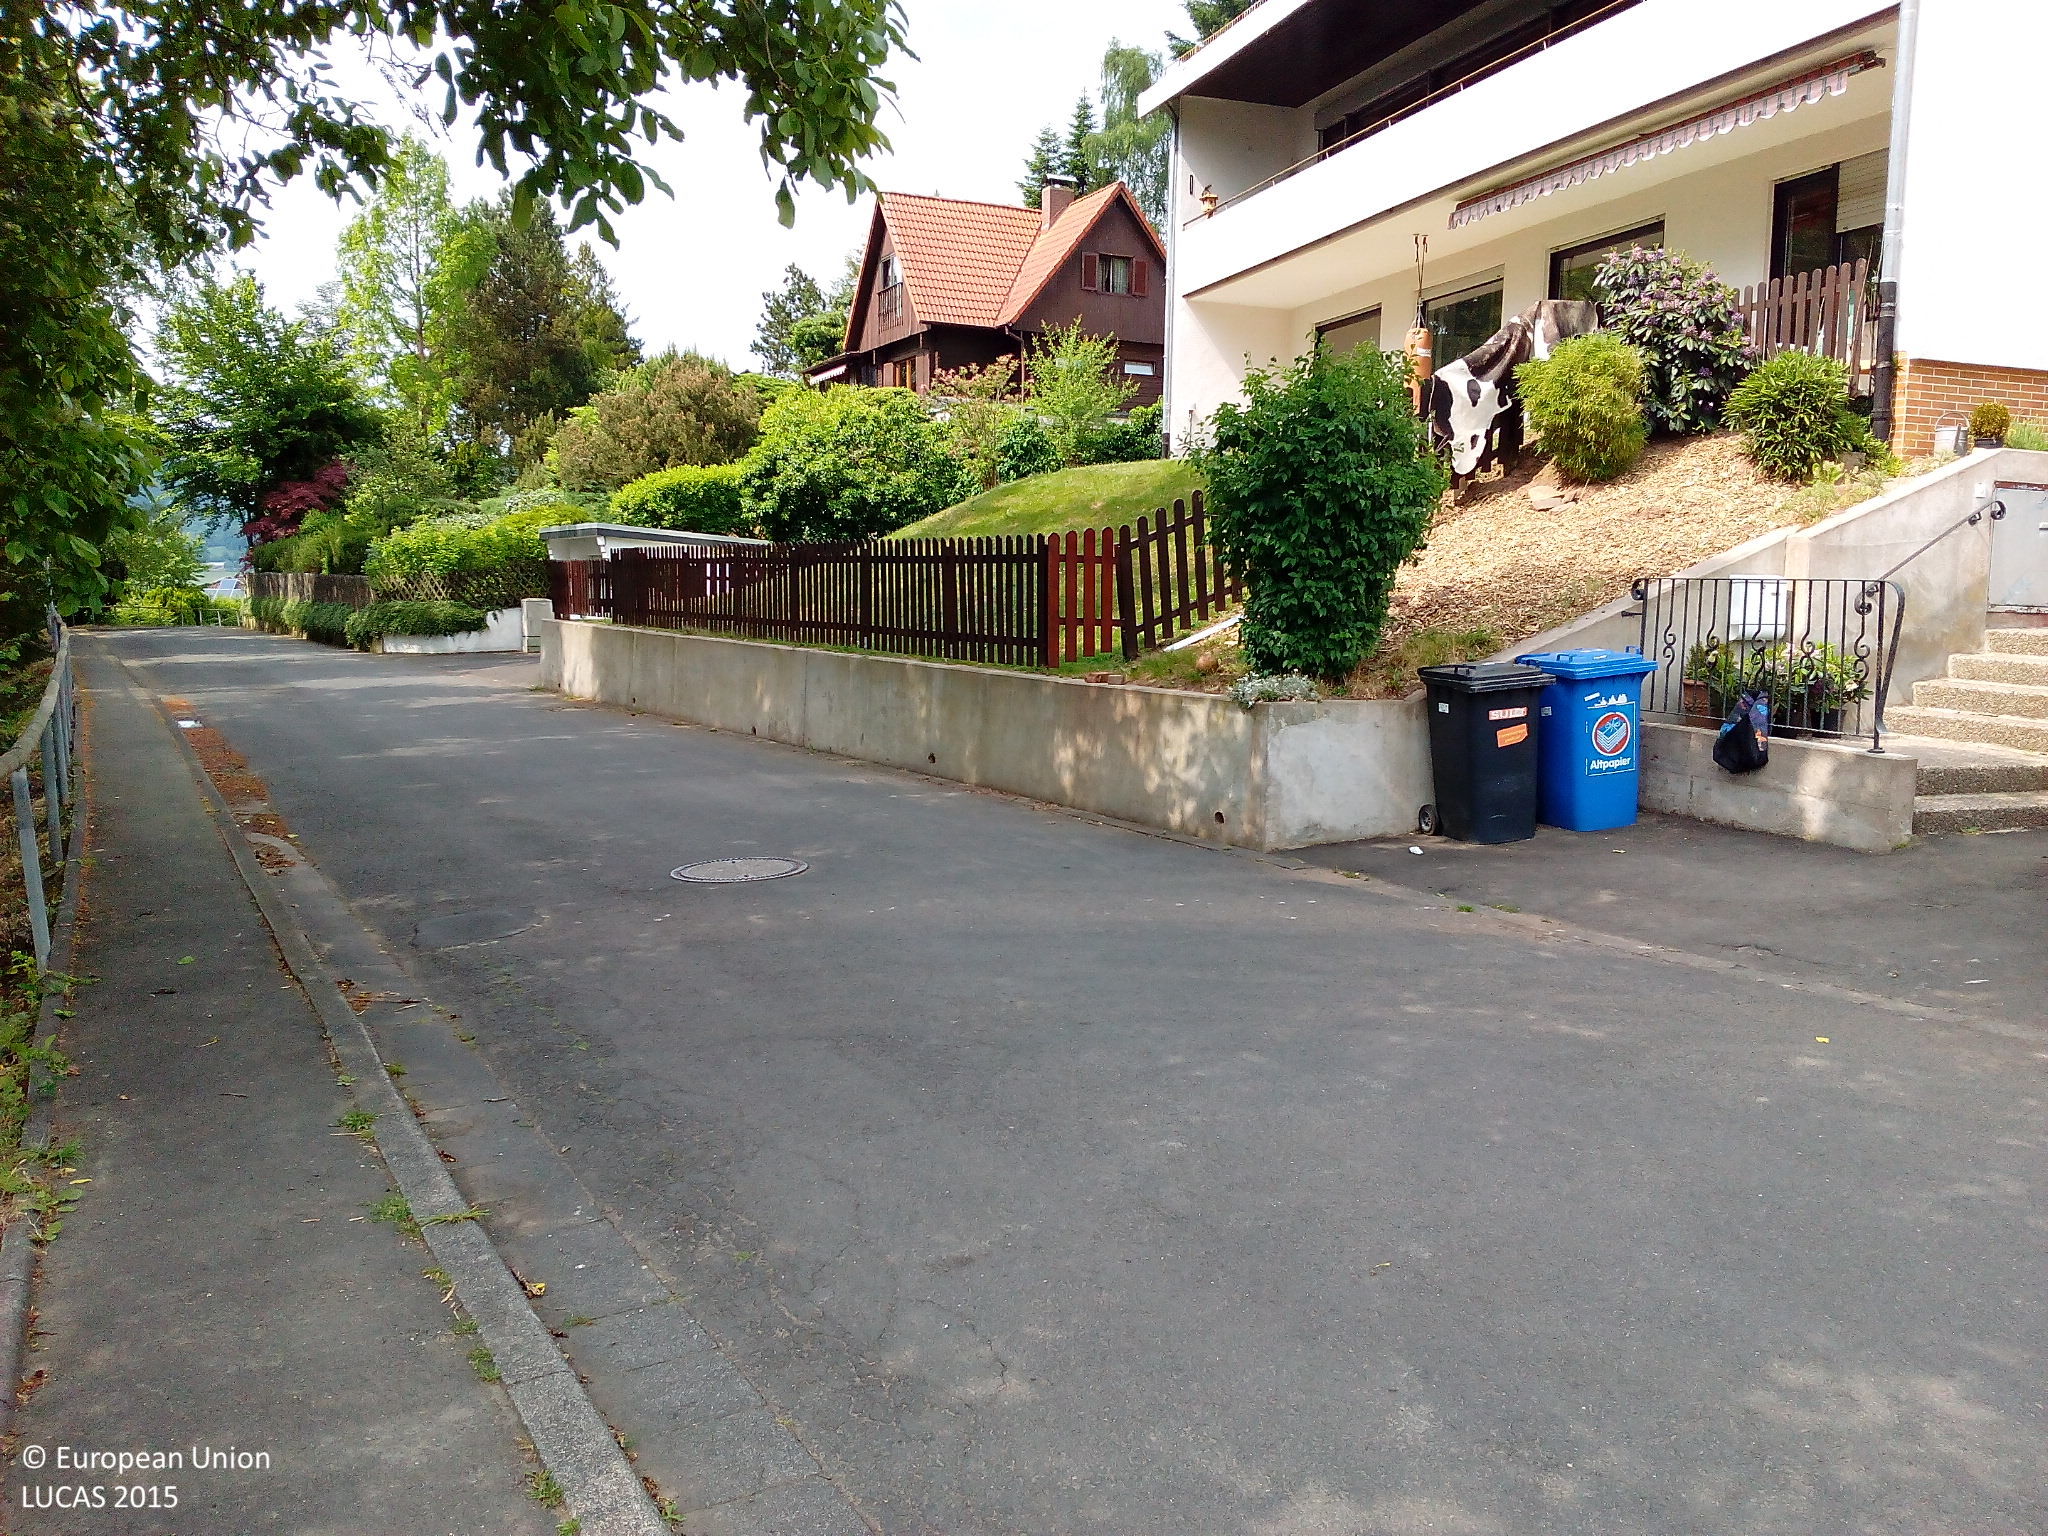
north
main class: Cropland
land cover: Apple fruit
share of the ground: 50 - 75 %
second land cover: Grassland without tree/shrub cover
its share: > 75 %
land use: Agriculture (excluding fallow land and kitchen gardens)
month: June
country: DE
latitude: 51.1187
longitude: 9.6715
